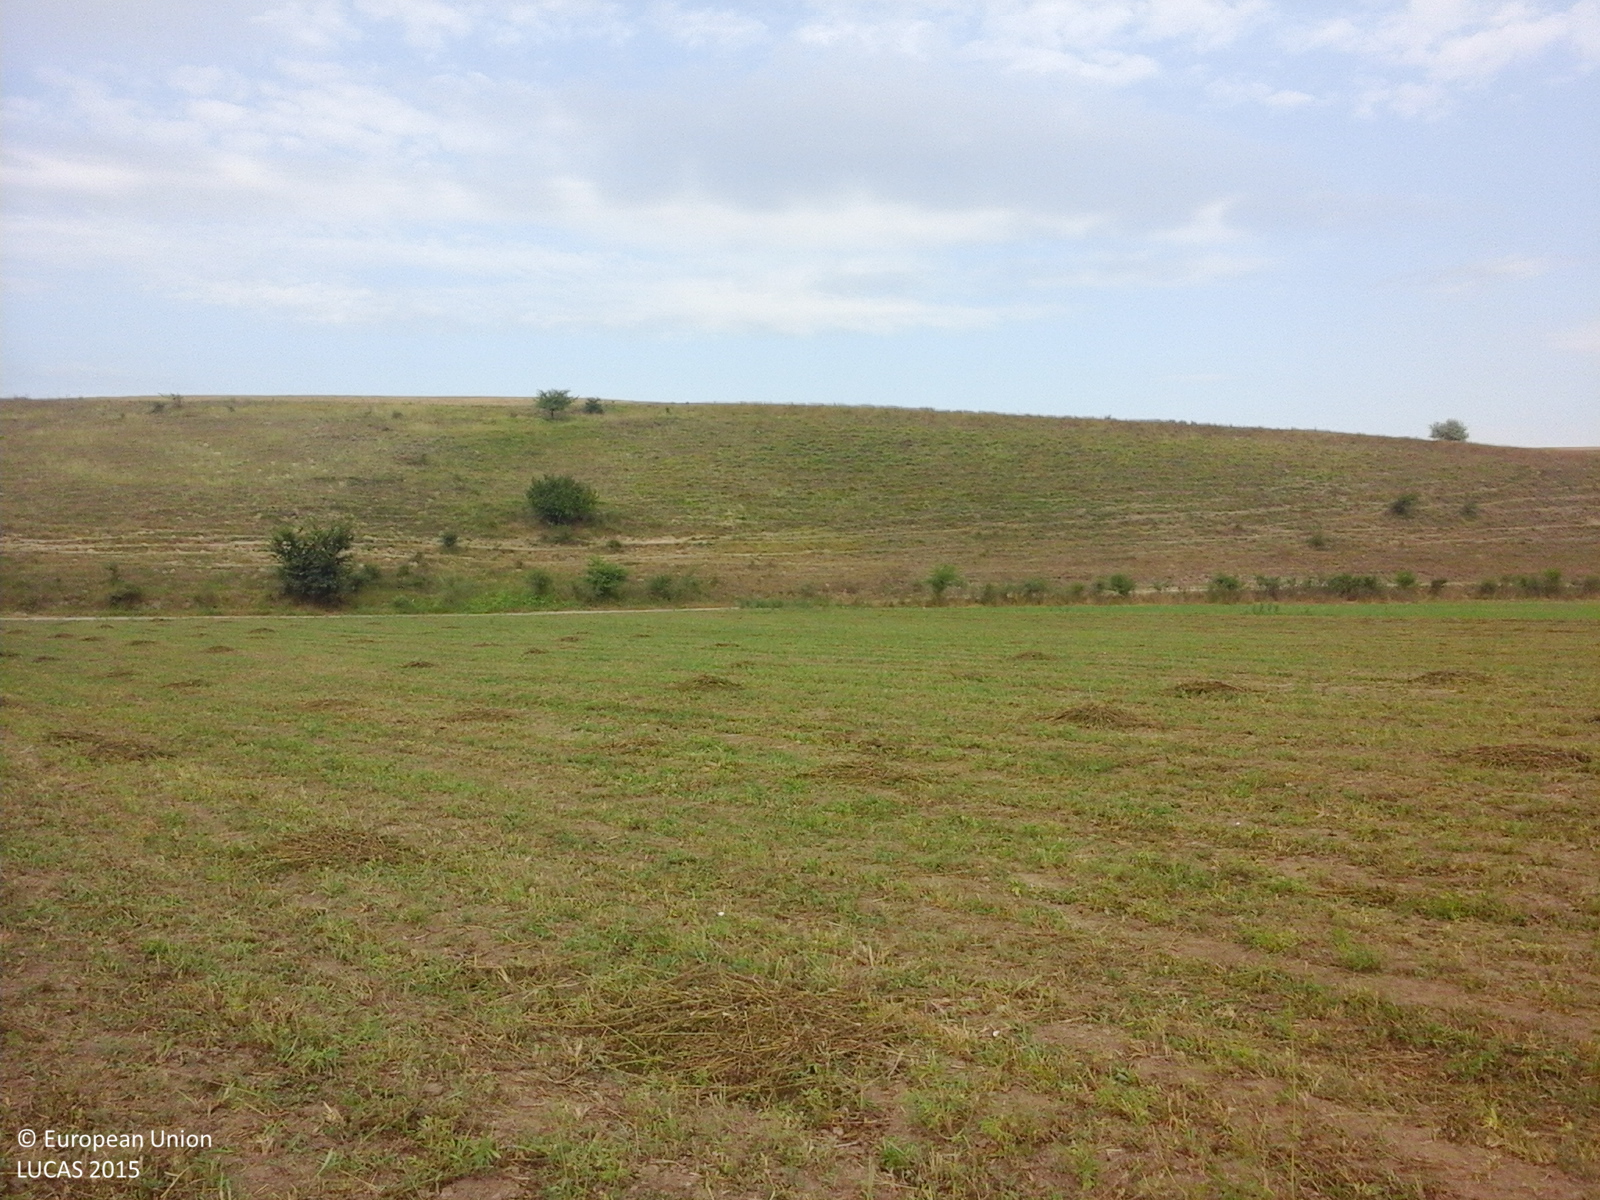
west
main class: Cropland
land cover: Lucerne
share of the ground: 10 - 25 %
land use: Agriculture (excluding fallow land and kitchen gardens)
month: August
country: RO
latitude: 44.1231
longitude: 27.9085
